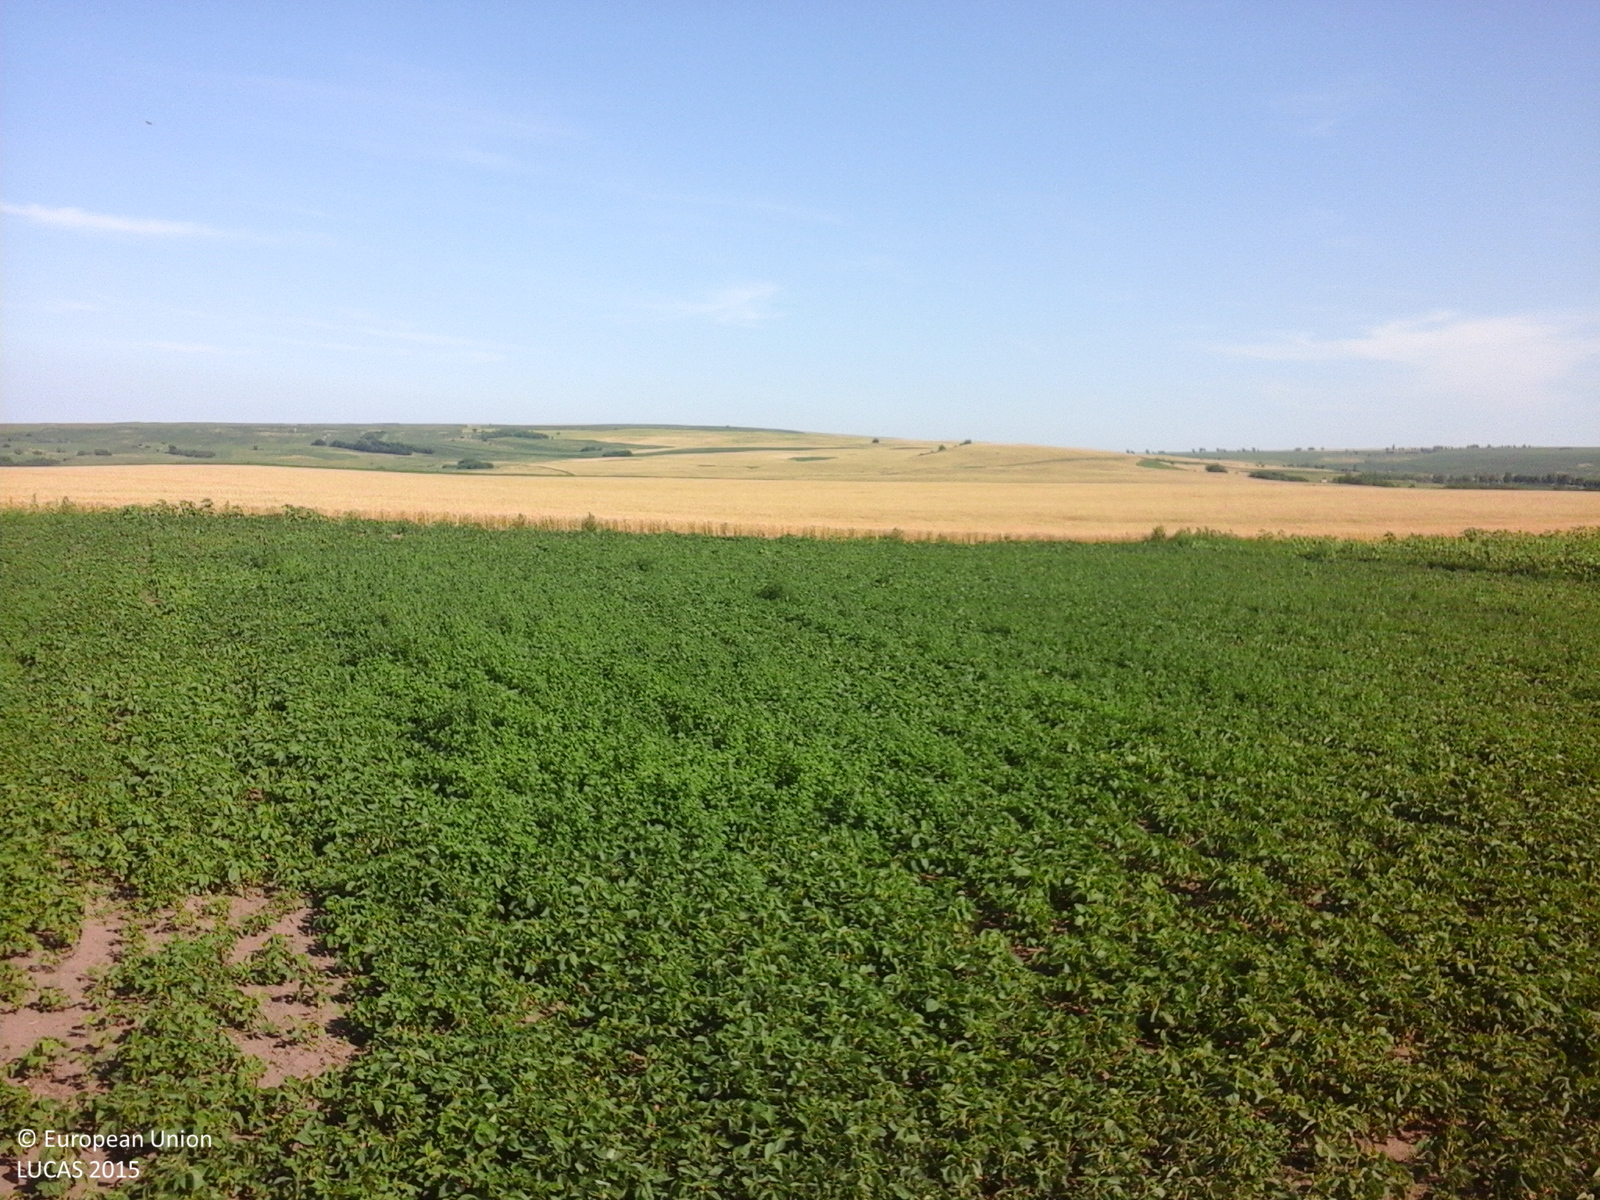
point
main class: Cropland
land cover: Common wheat
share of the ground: > 75 %
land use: Agriculture (excluding fallow land and kitchen gardens)
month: June
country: RO
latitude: 48.2255
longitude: 26.8075
